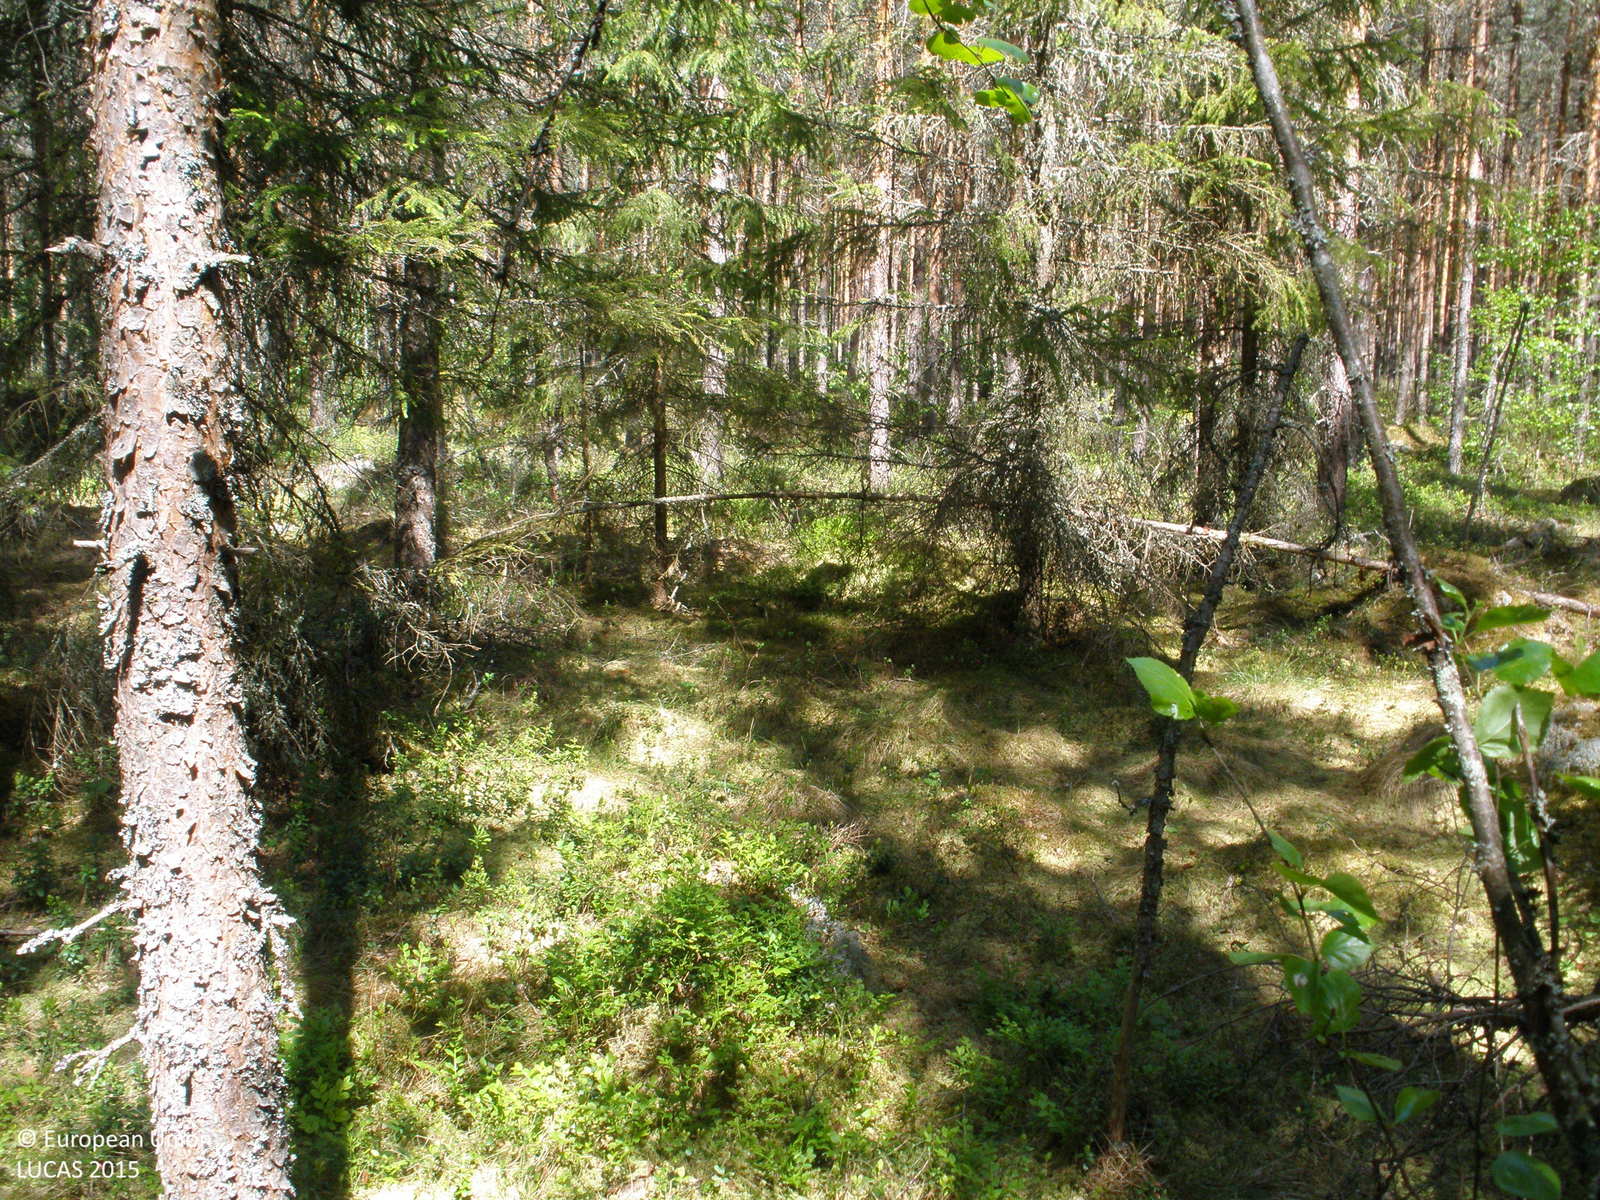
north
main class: Woodland
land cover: Pine dominated coniferous woodland
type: boreal forest
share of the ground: > 75 %
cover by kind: coniferous forest trees 80 %, herbaceous plants 10 %, broadleaved forest trees 5 %, lichens and mosses 5 %
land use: Forestry
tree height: > 5 m
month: June
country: FI
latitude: 60.7687
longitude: 23.5417
